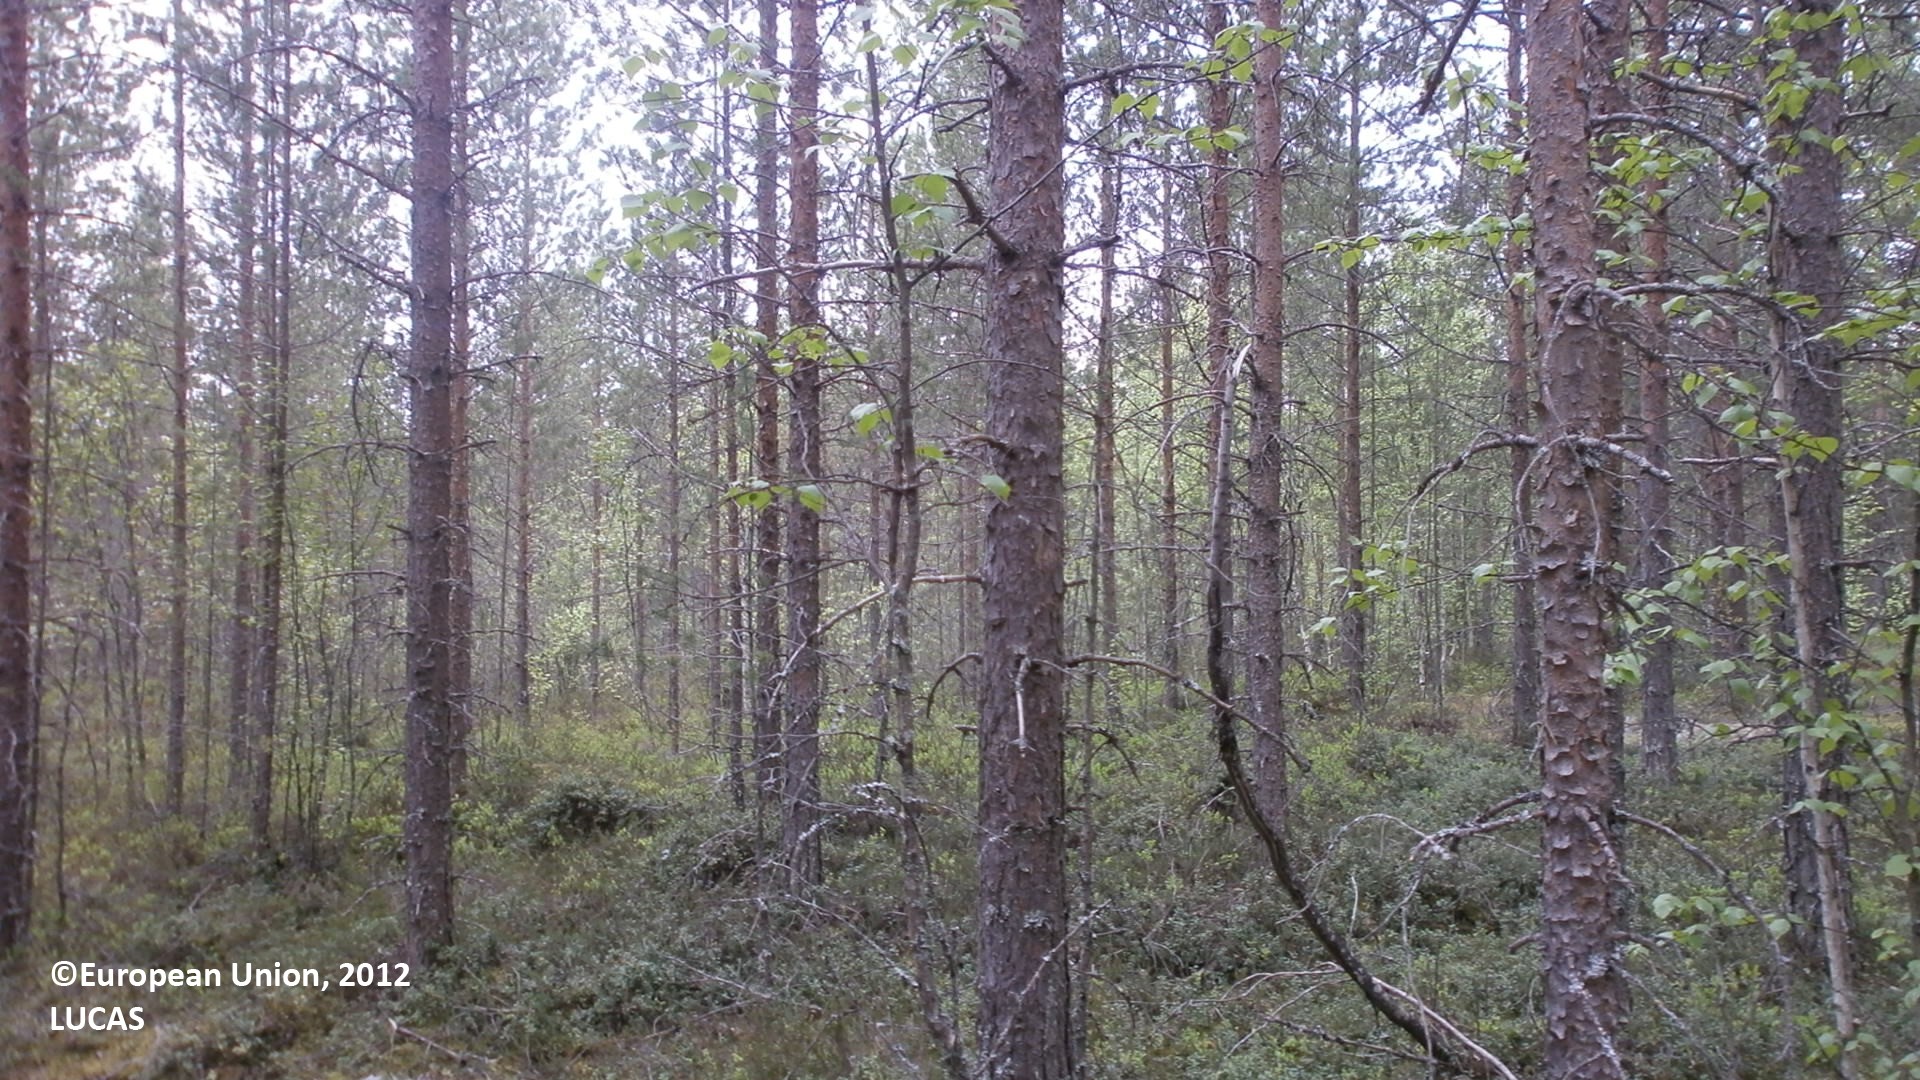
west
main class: Woodland
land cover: Pine dominated coniferous woodland
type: mire and swamp forests
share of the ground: 50 - 75 %
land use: Forestry
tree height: > 5 m
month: June
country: FI
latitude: 64.3883
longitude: 25.1149
